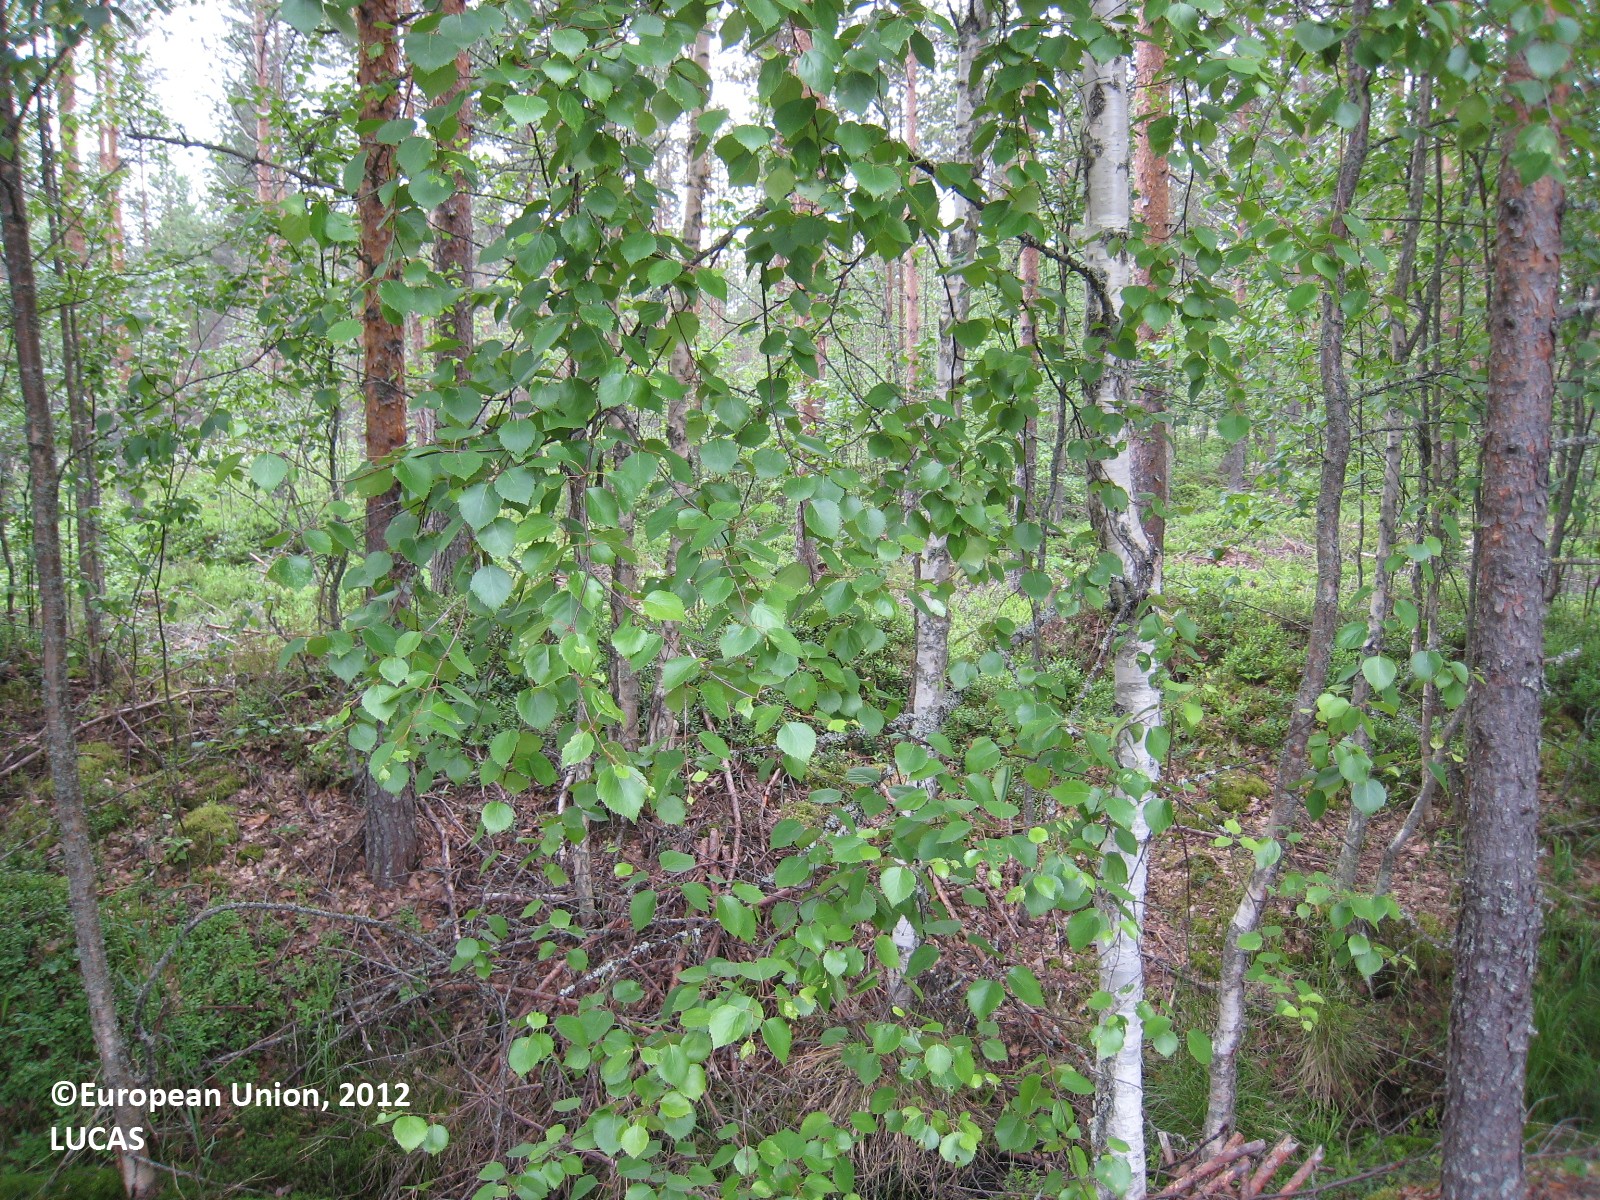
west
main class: Woodland
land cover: Pine dominated coniferous woodland
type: boreal forest
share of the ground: 50 - 75 %
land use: Forestry
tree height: > 5 m
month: June
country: FI
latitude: 61.9473
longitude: 26.2033
